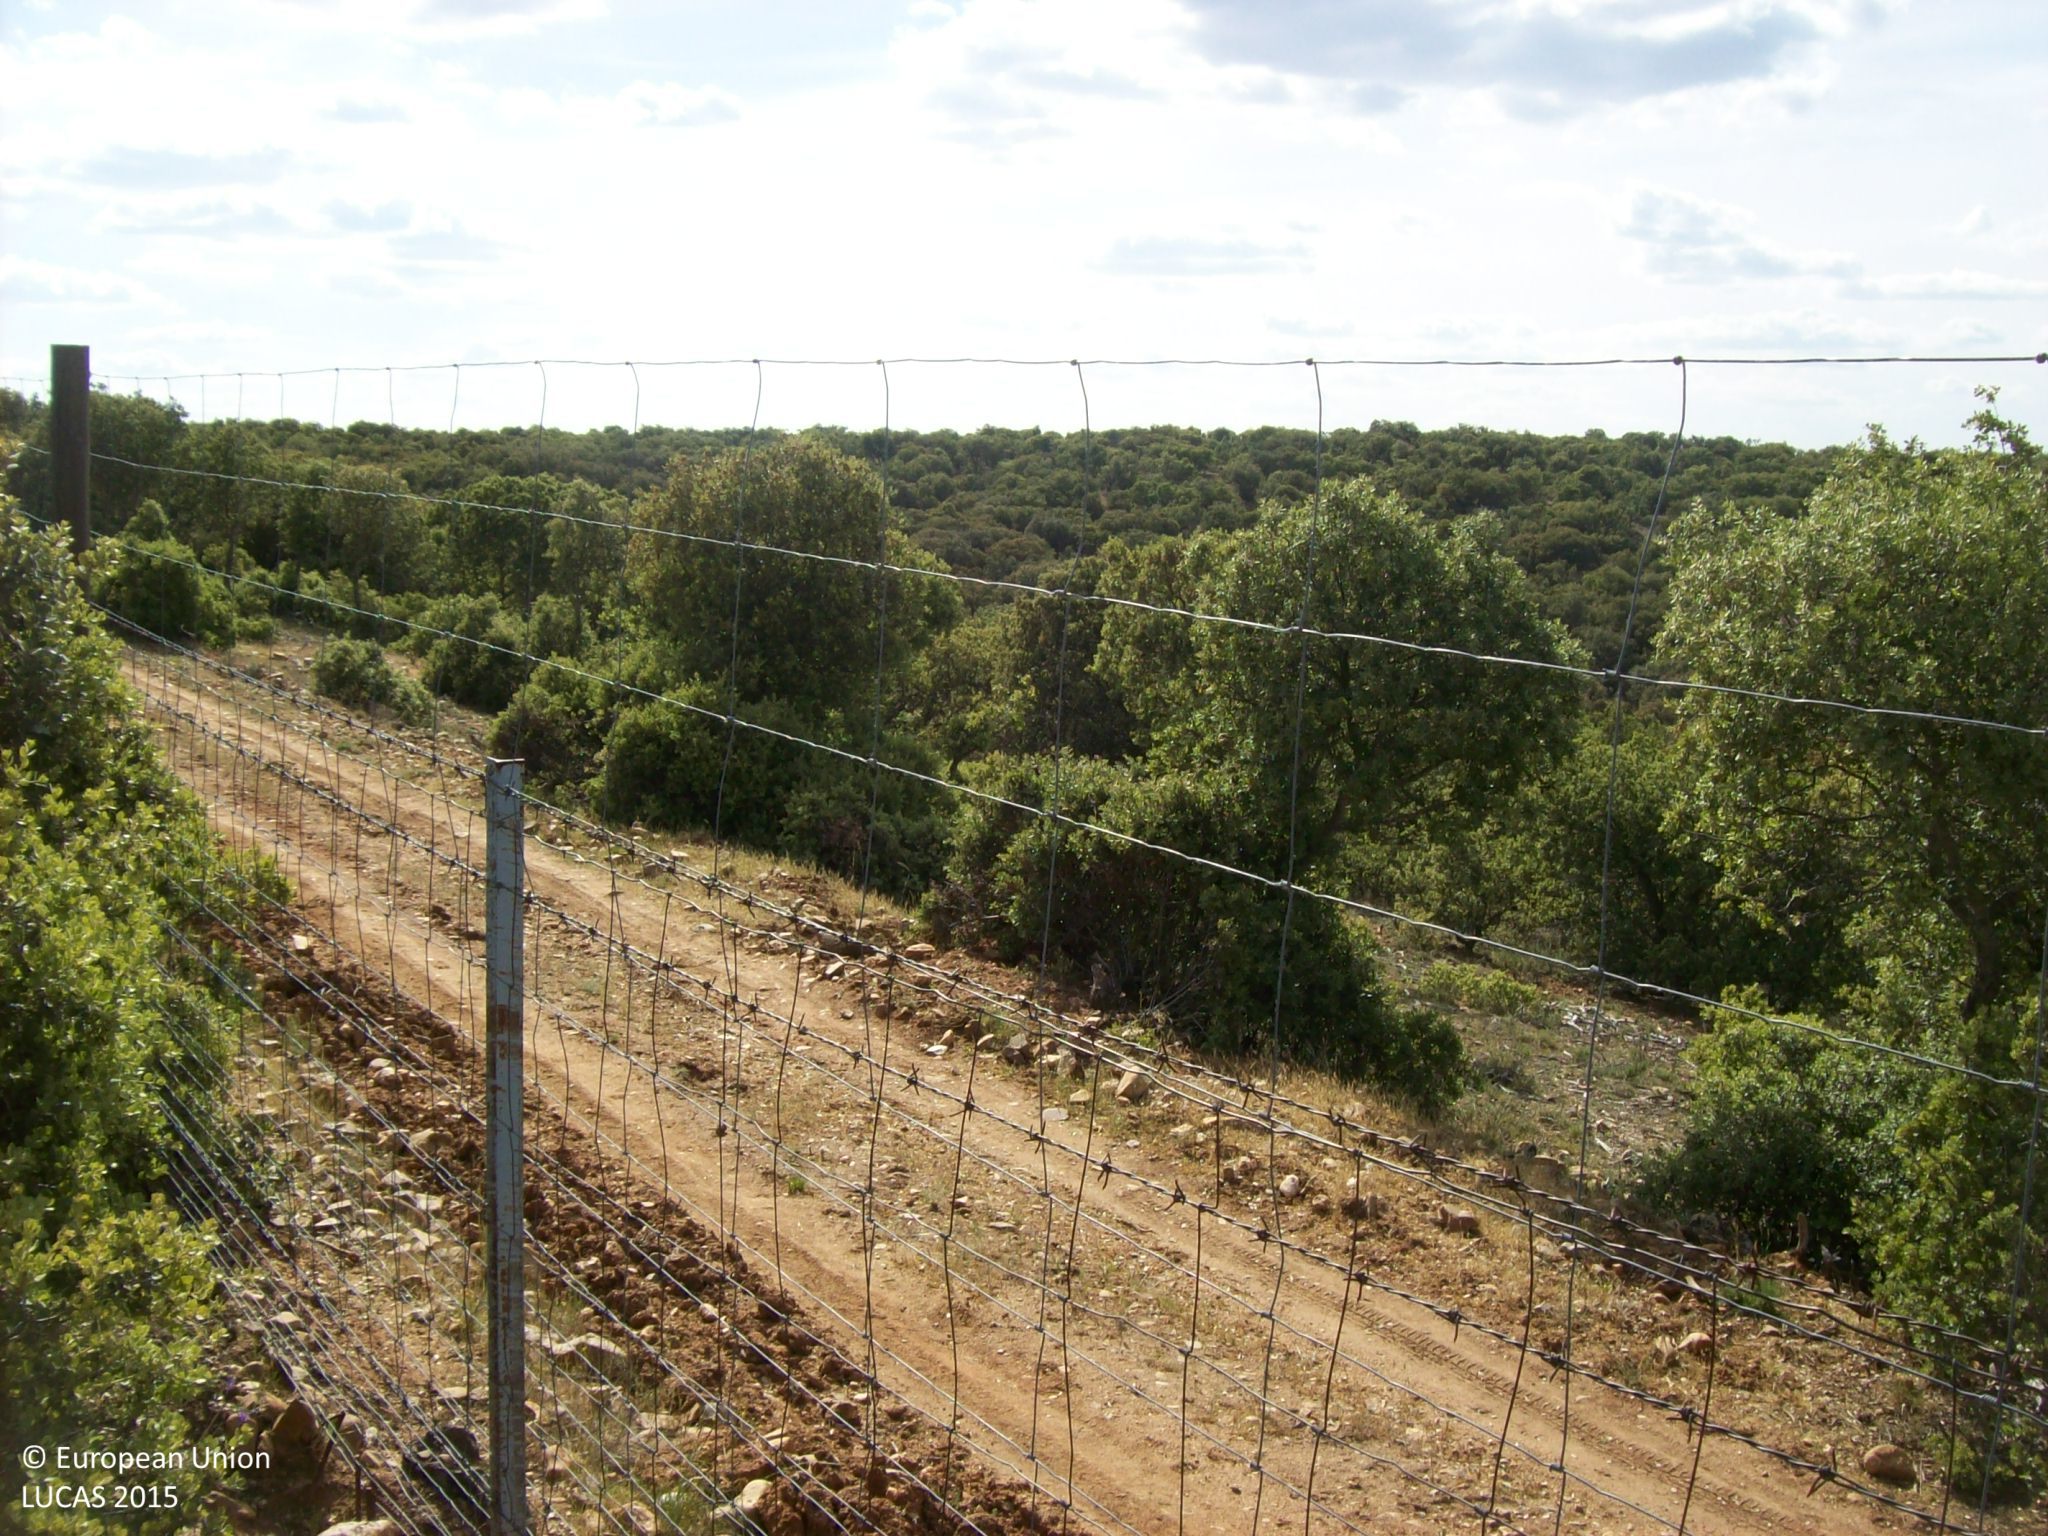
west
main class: Woodland
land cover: Broadleaved woodland
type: broadleaved evergreen forest
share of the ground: 50 - 75 %
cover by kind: broadleaved forest trees 60 %, herbaceous plants 15 %, shrubs 10 %, unconsolidated bare surface 10 %, lichens and mosses 5 %
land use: Forestry
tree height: > 5 m
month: May
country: ES
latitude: 40.8685
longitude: -4.5188
